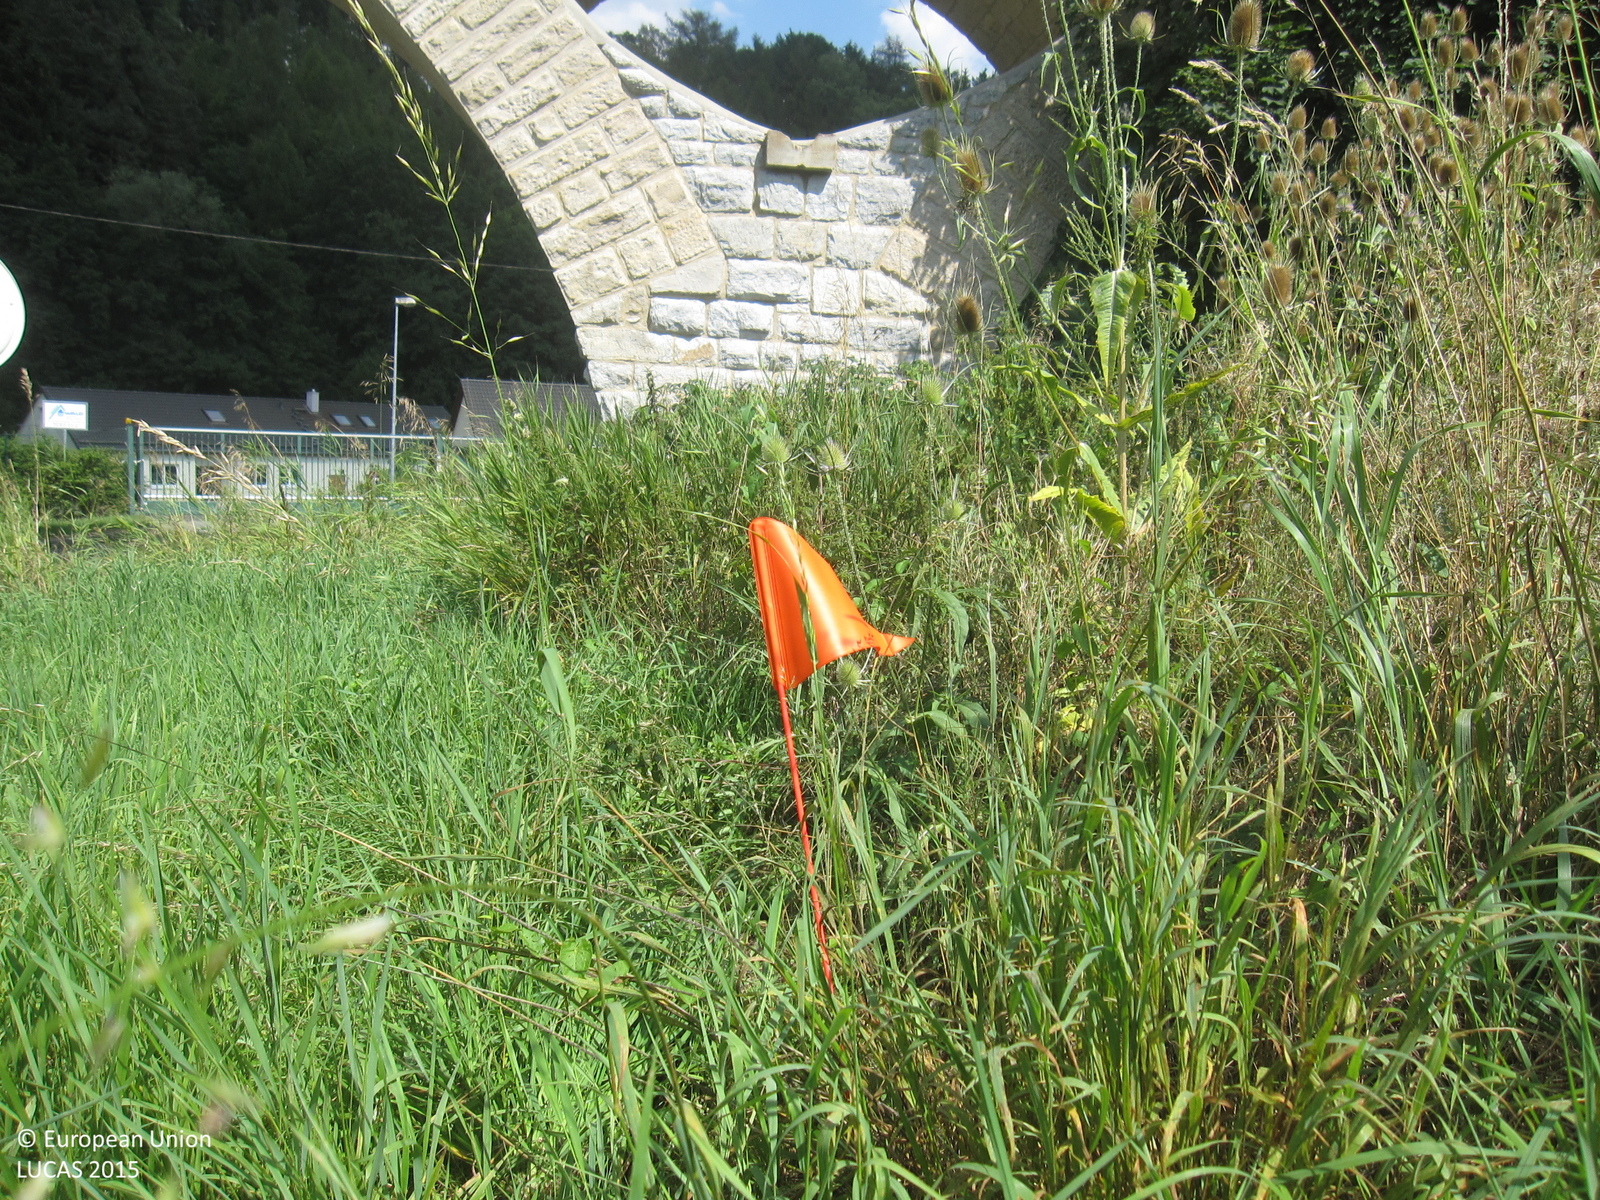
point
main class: Grassland
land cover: Grassland without tree/shrub cover
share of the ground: > 75 %
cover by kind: herbaceous plants 95 %, unconsolidated bare surface 5 %
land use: Semi-natural and natural areas not in use
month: August
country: DE
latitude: 50.4421
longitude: 11.6471
